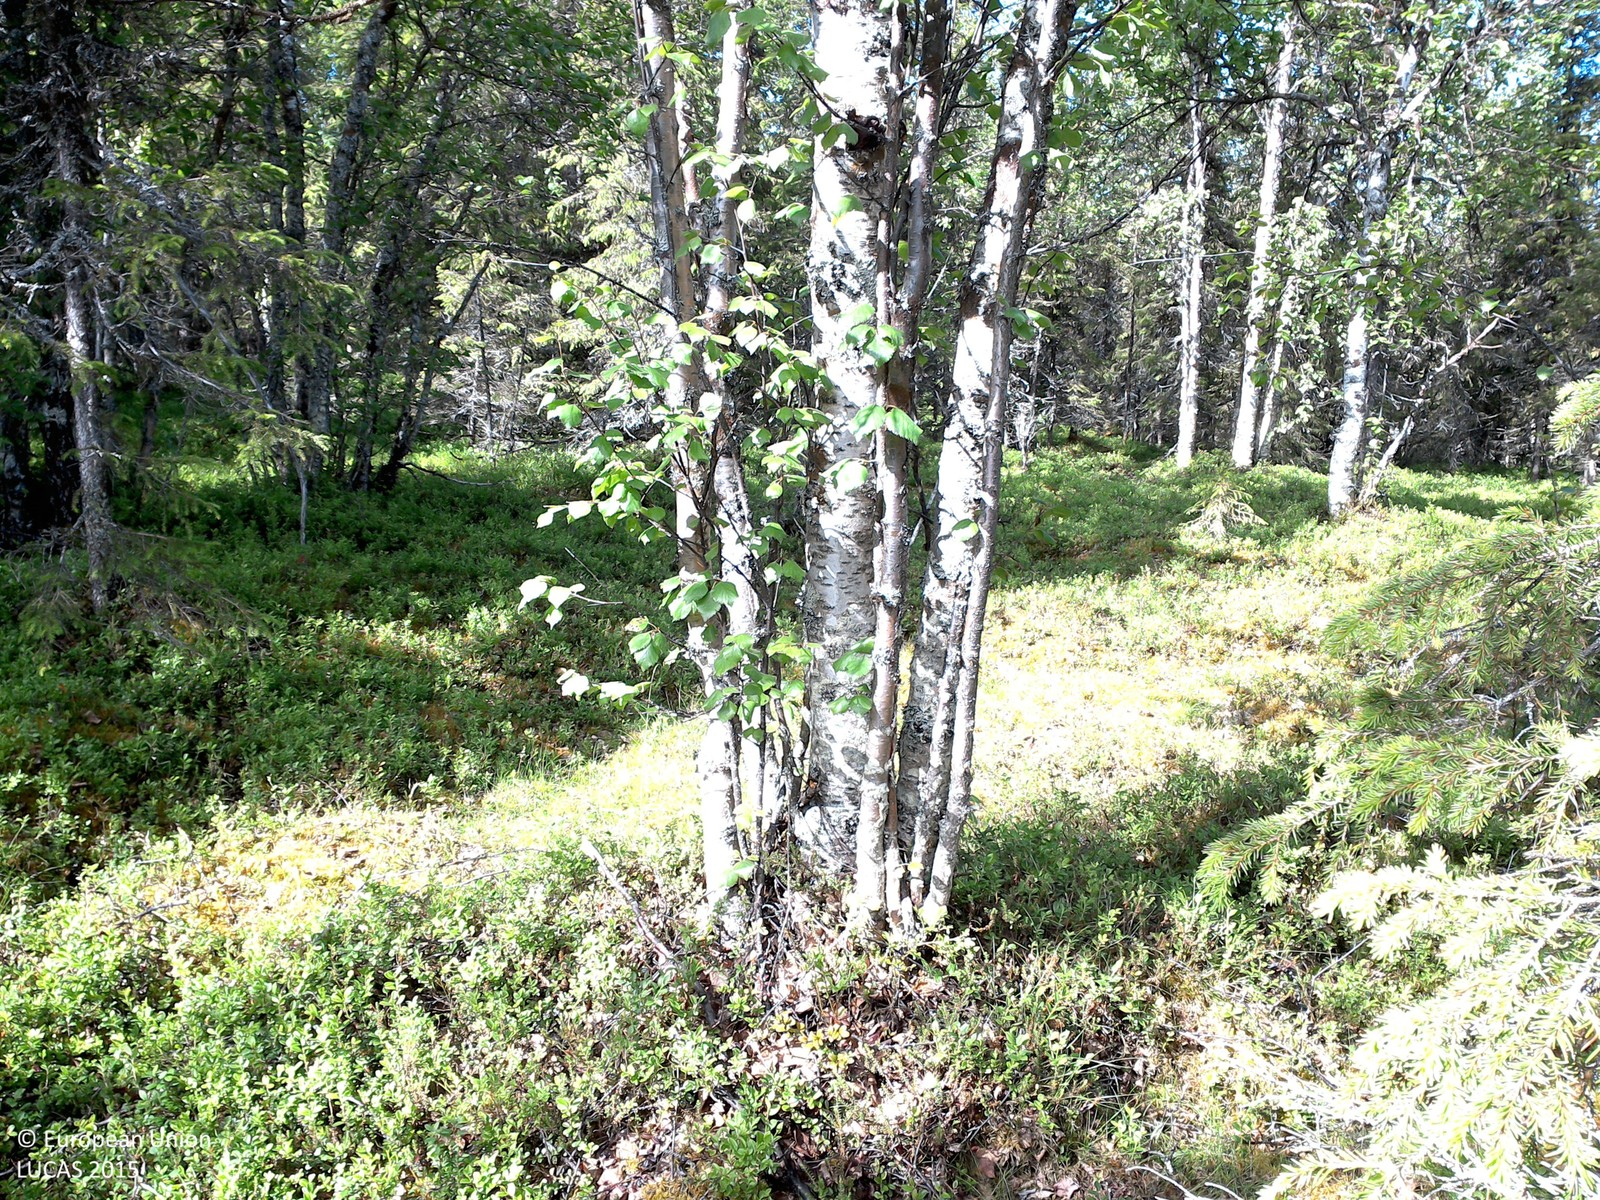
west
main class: Woodland
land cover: Spruce dominated mixed woodland
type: boreal forest
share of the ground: 25 - 50 %
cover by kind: shrubs 50 %, coniferous forest trees 25 %, broadleaved forest trees 15 %, lichens and mosses 10 %
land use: Forestry
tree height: > 5 m
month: July
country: SE
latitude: 67.6216
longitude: 21.2678
